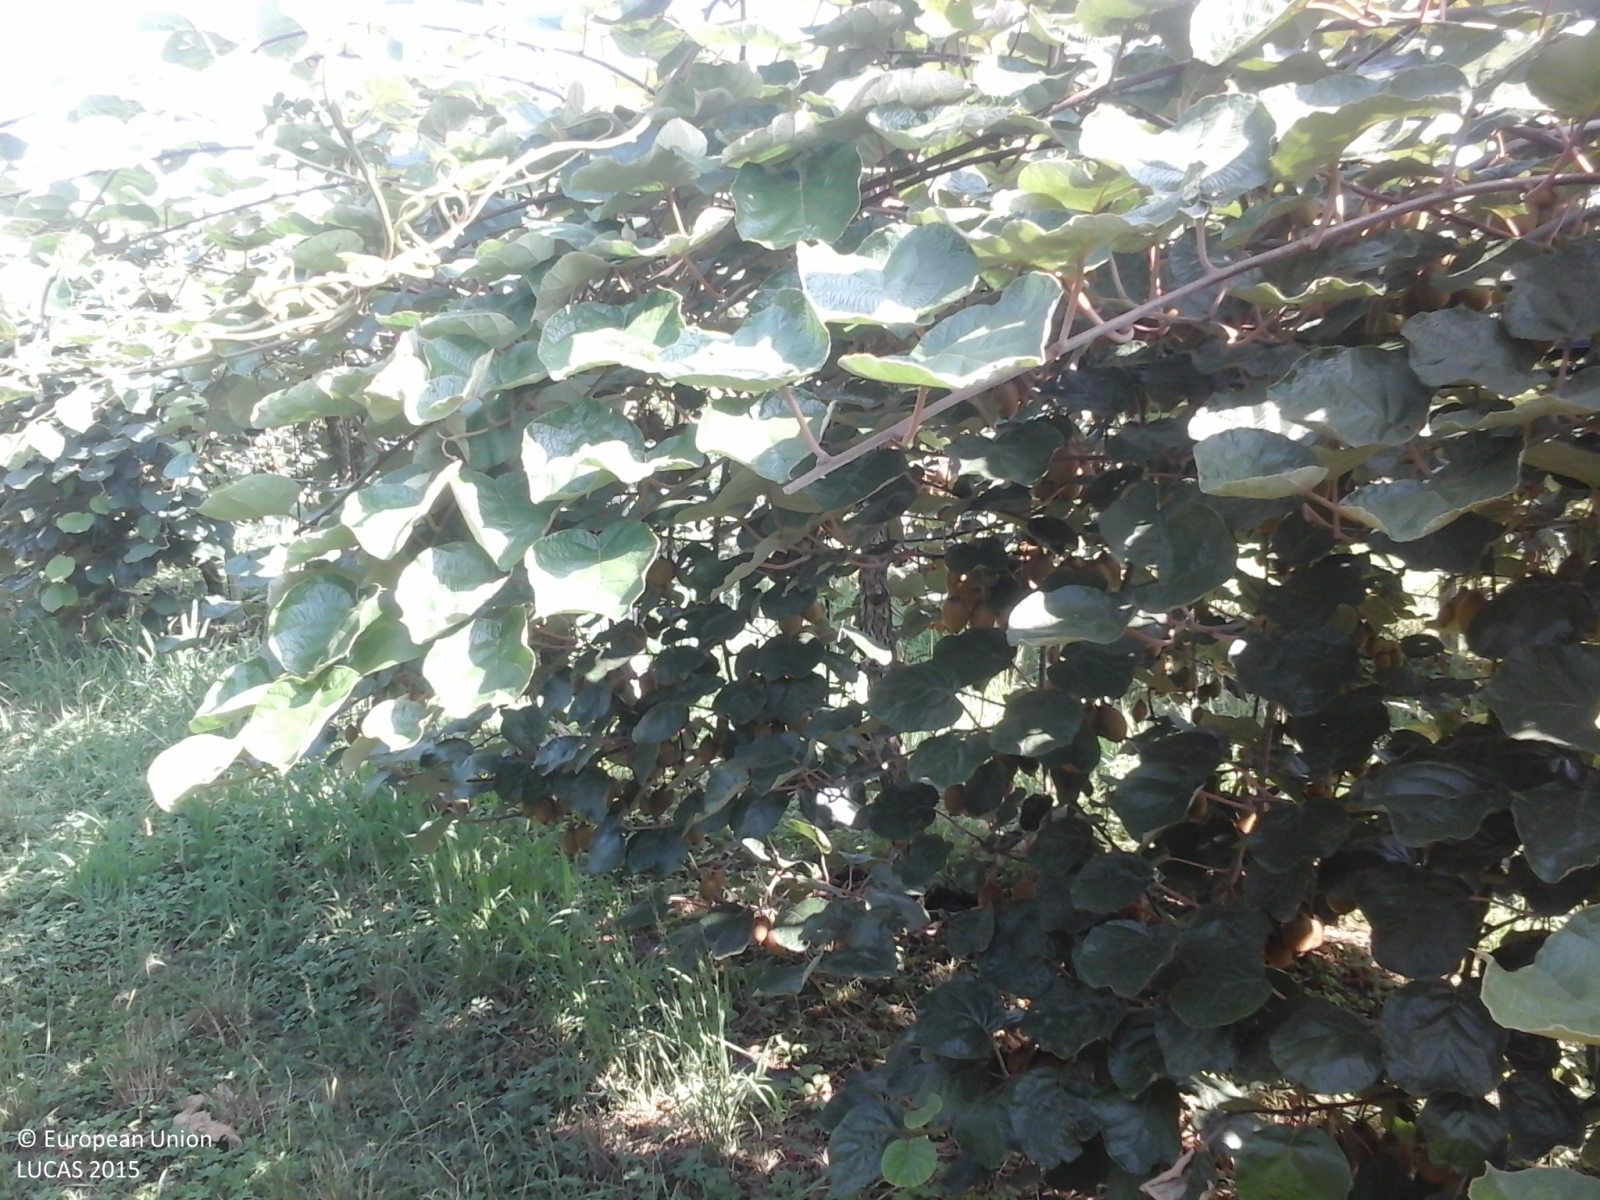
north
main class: Cropland
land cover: Other fruit trees and berries
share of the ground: > 75 %
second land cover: Grassland without tree/shrub cover
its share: > 75 %
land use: Agriculture (excluding fallow land and kitchen gardens)
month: July
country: IT
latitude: 45.3211
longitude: 10.8023
